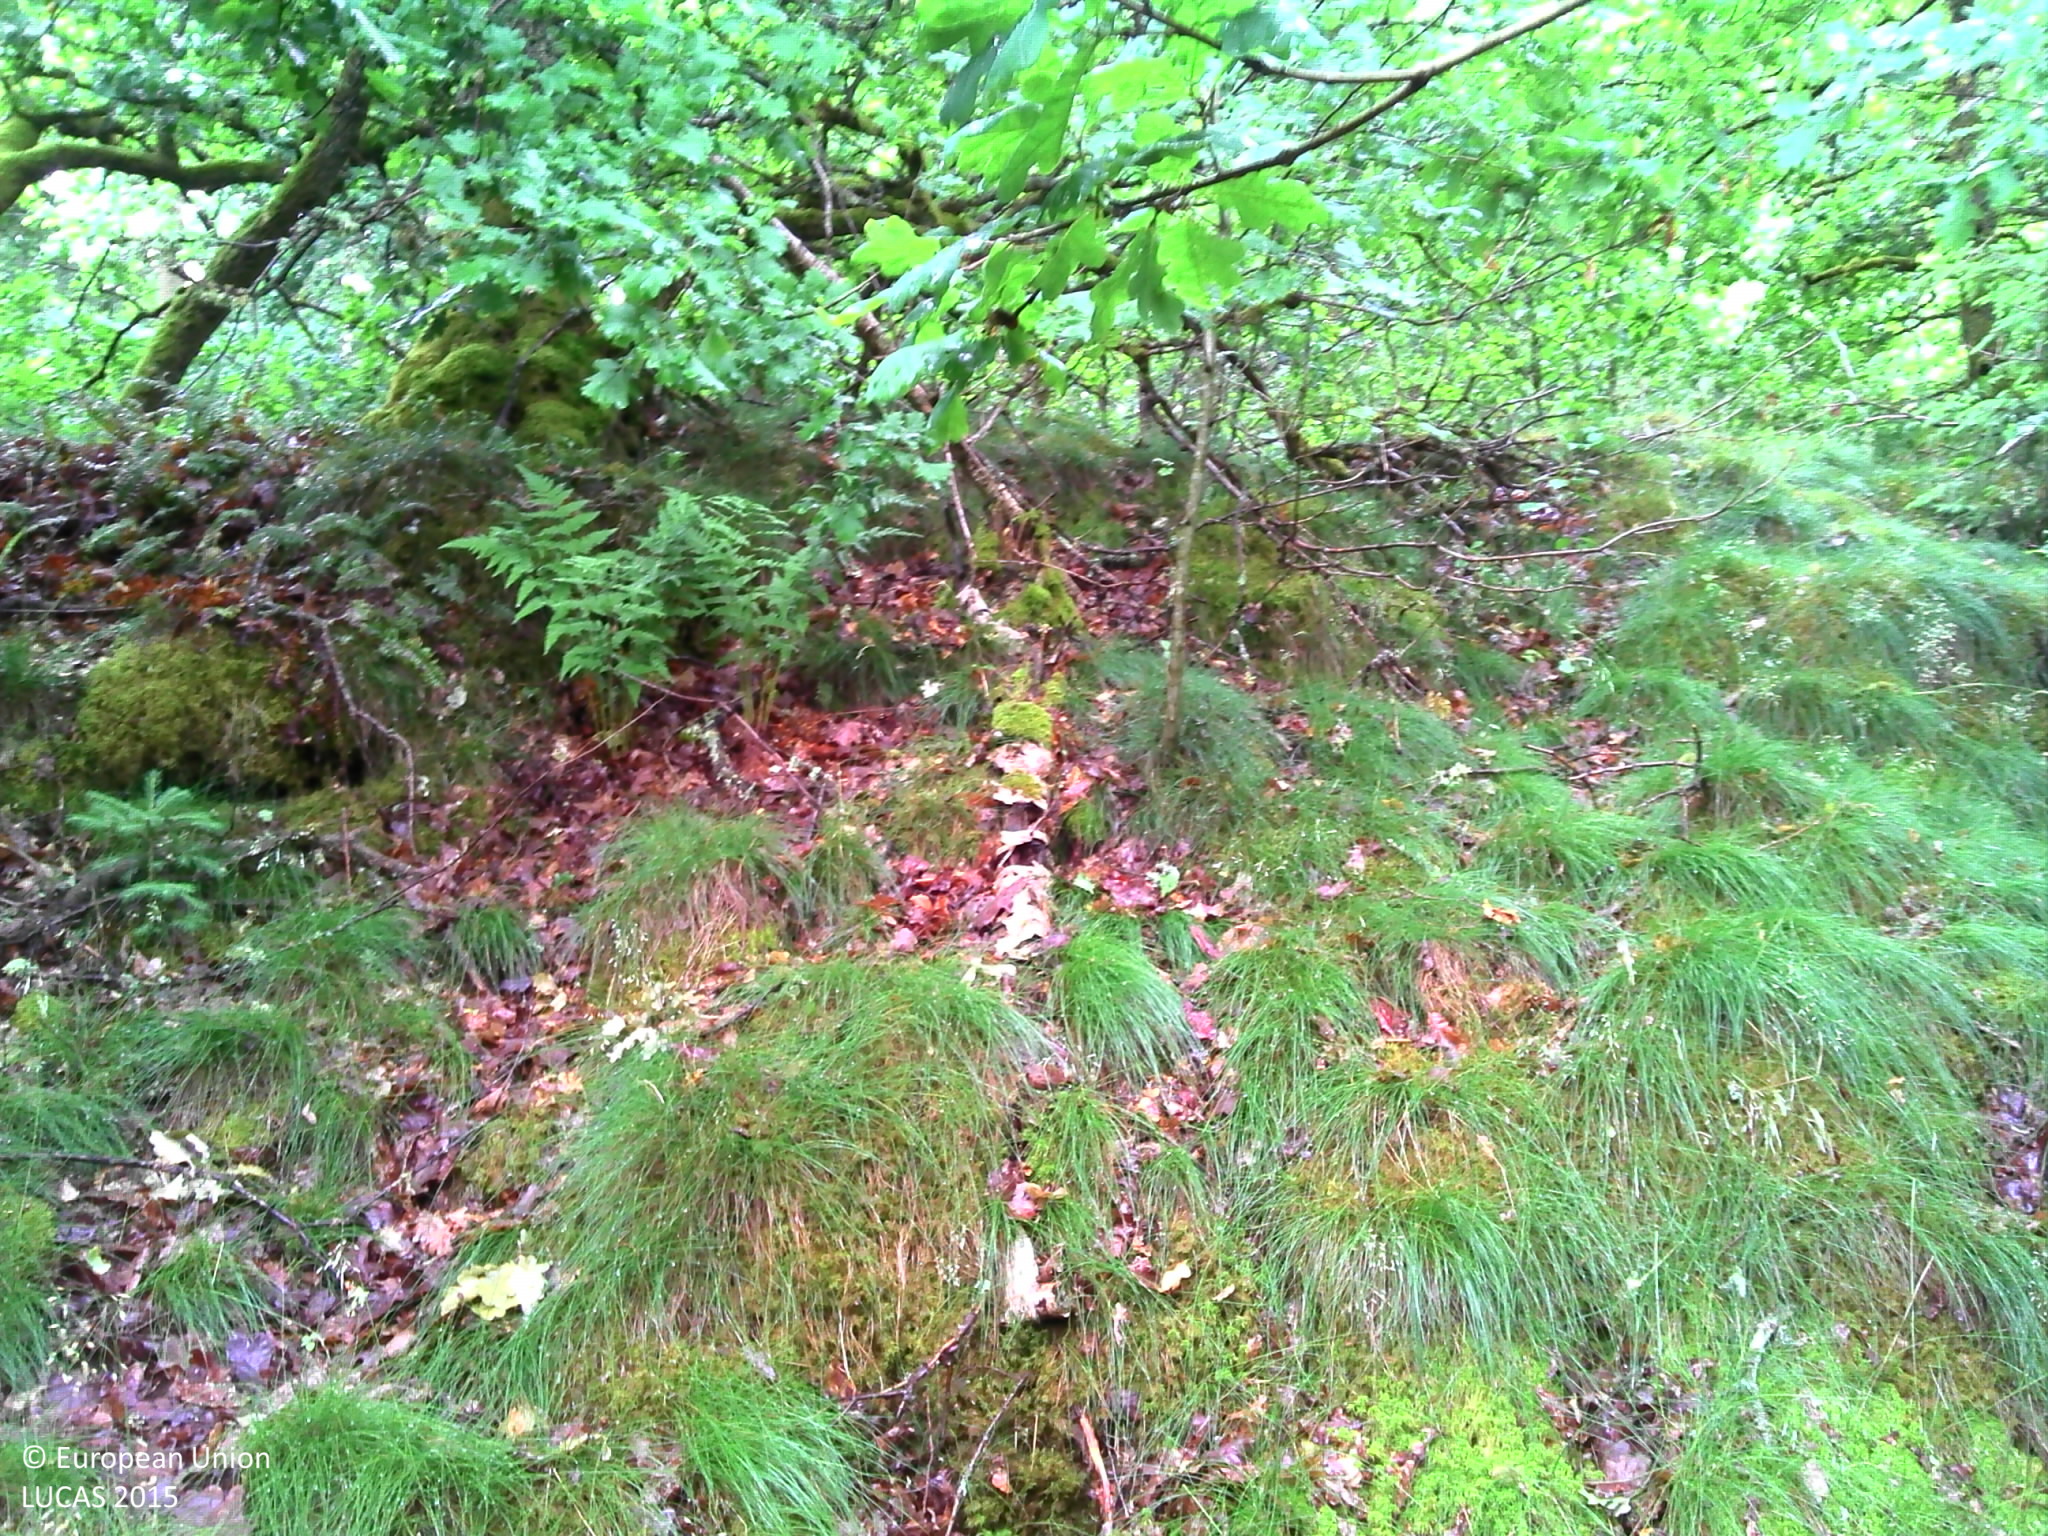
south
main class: Woodland
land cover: Broadleaved woodland
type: acidophilous oak and oak-birch forest
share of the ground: > 75 %
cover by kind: broadleaved forest trees 95 %, herbaceous plants 5 %
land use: Forestry
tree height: > 5 m
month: June
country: BE
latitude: 50.1867
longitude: 5.5305
